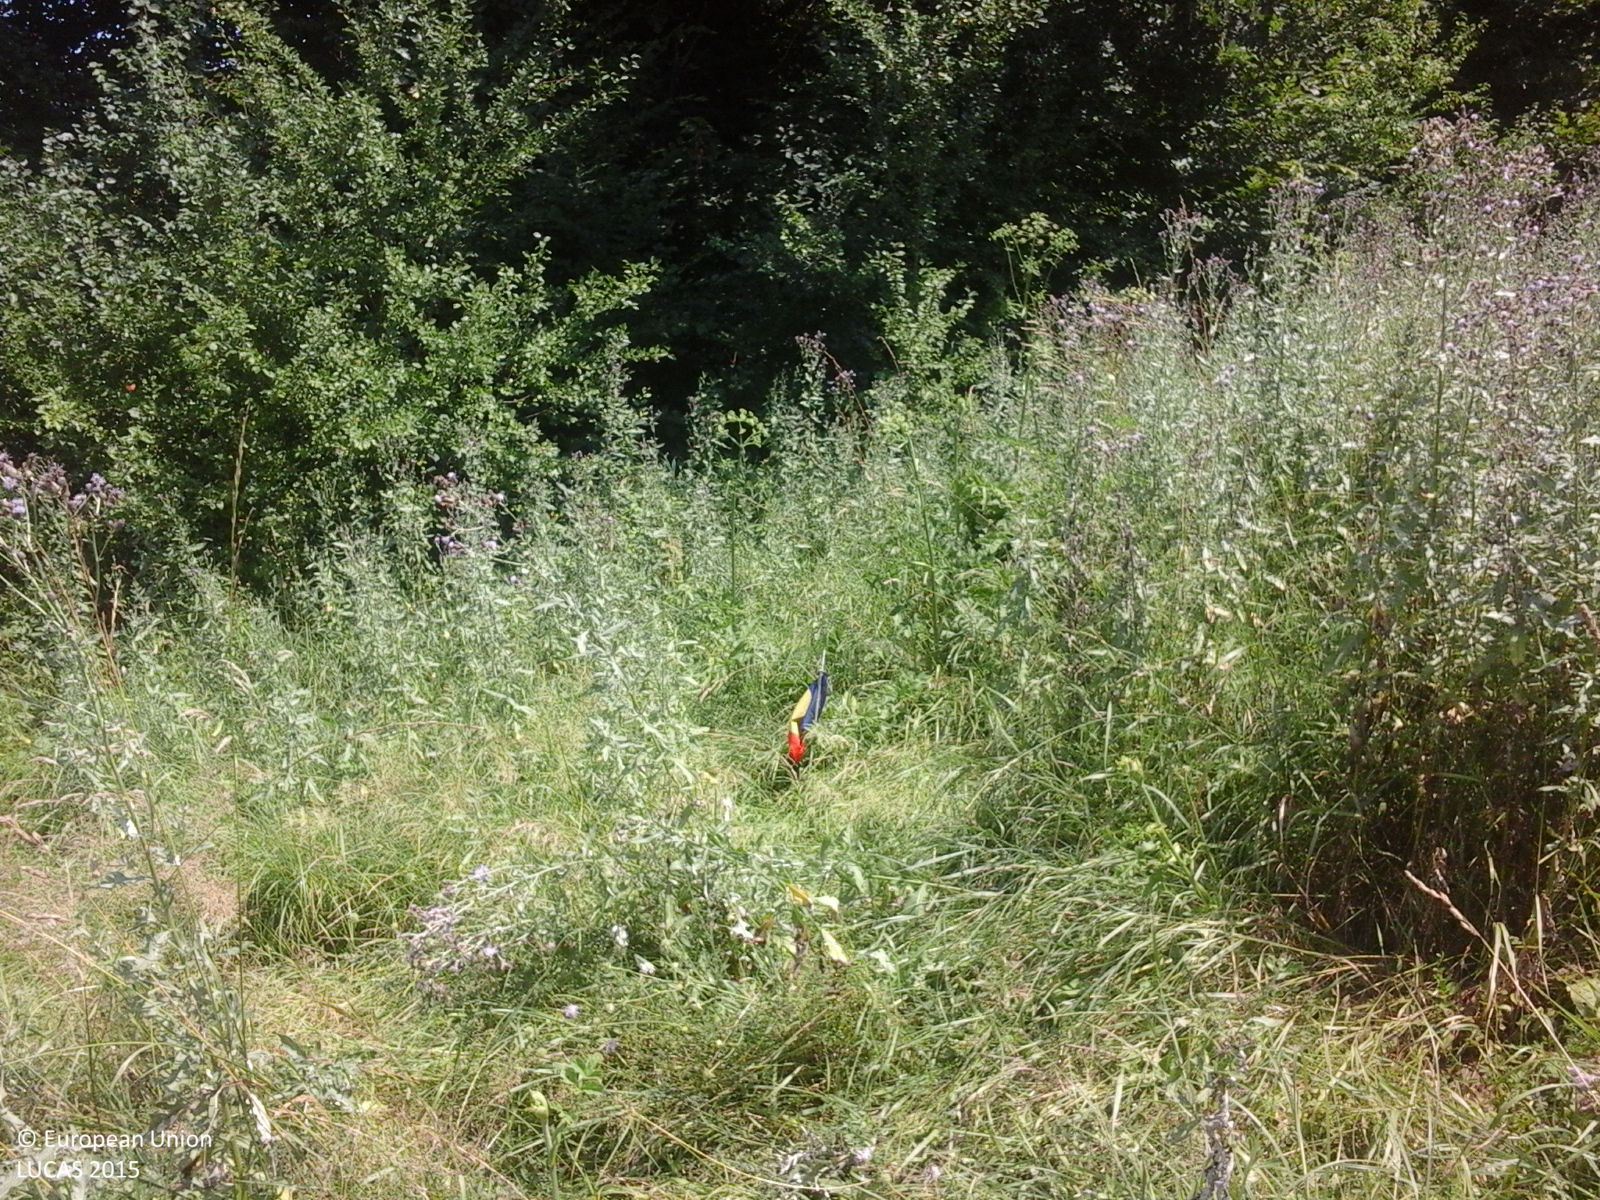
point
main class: Cropland
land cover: Other fruit trees and berries
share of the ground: 25 - 50 %
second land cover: Spontaneously vegetated surfaces
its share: > 75 %
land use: Agriculture (excluding fallow land and kitchen gardens)
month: July
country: RO
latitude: 45.0865
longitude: 24.4703
